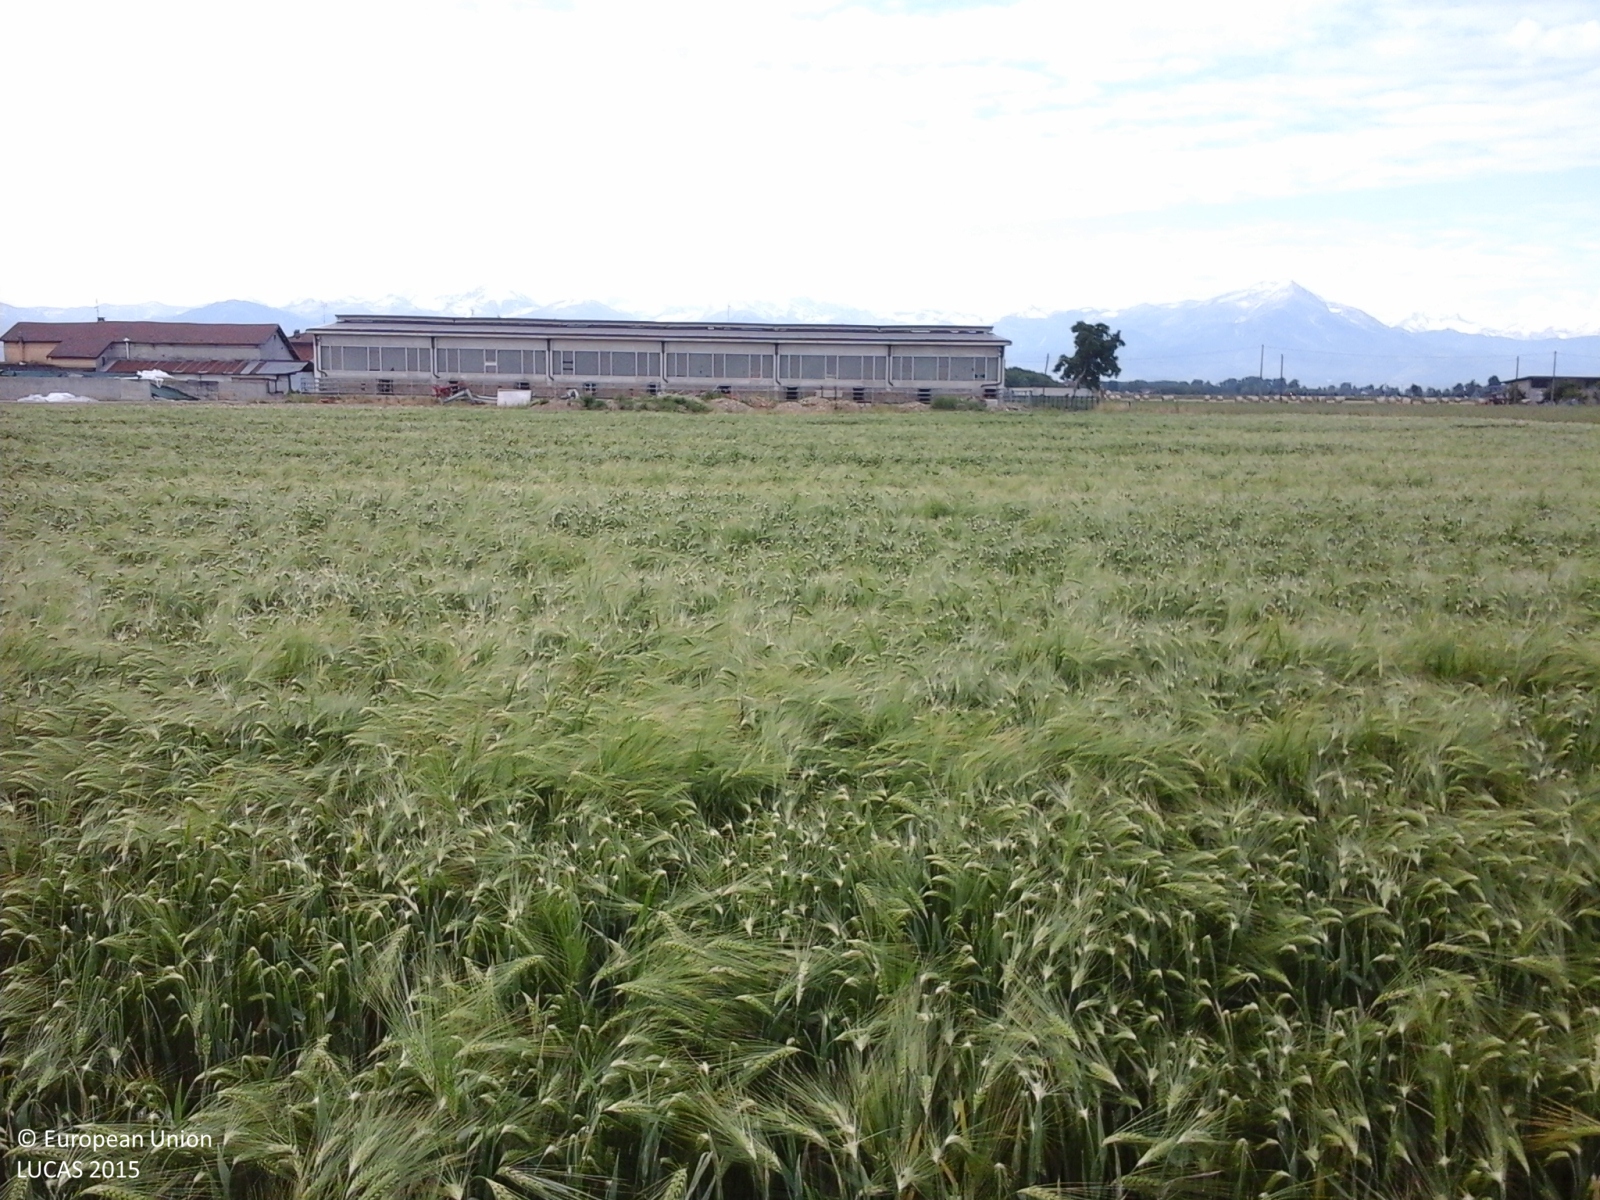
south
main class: Cropland
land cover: Barley
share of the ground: > 75 %
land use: Agriculture (excluding fallow land and kitchen gardens)
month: May
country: IT
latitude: 44.4695
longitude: 7.7044
